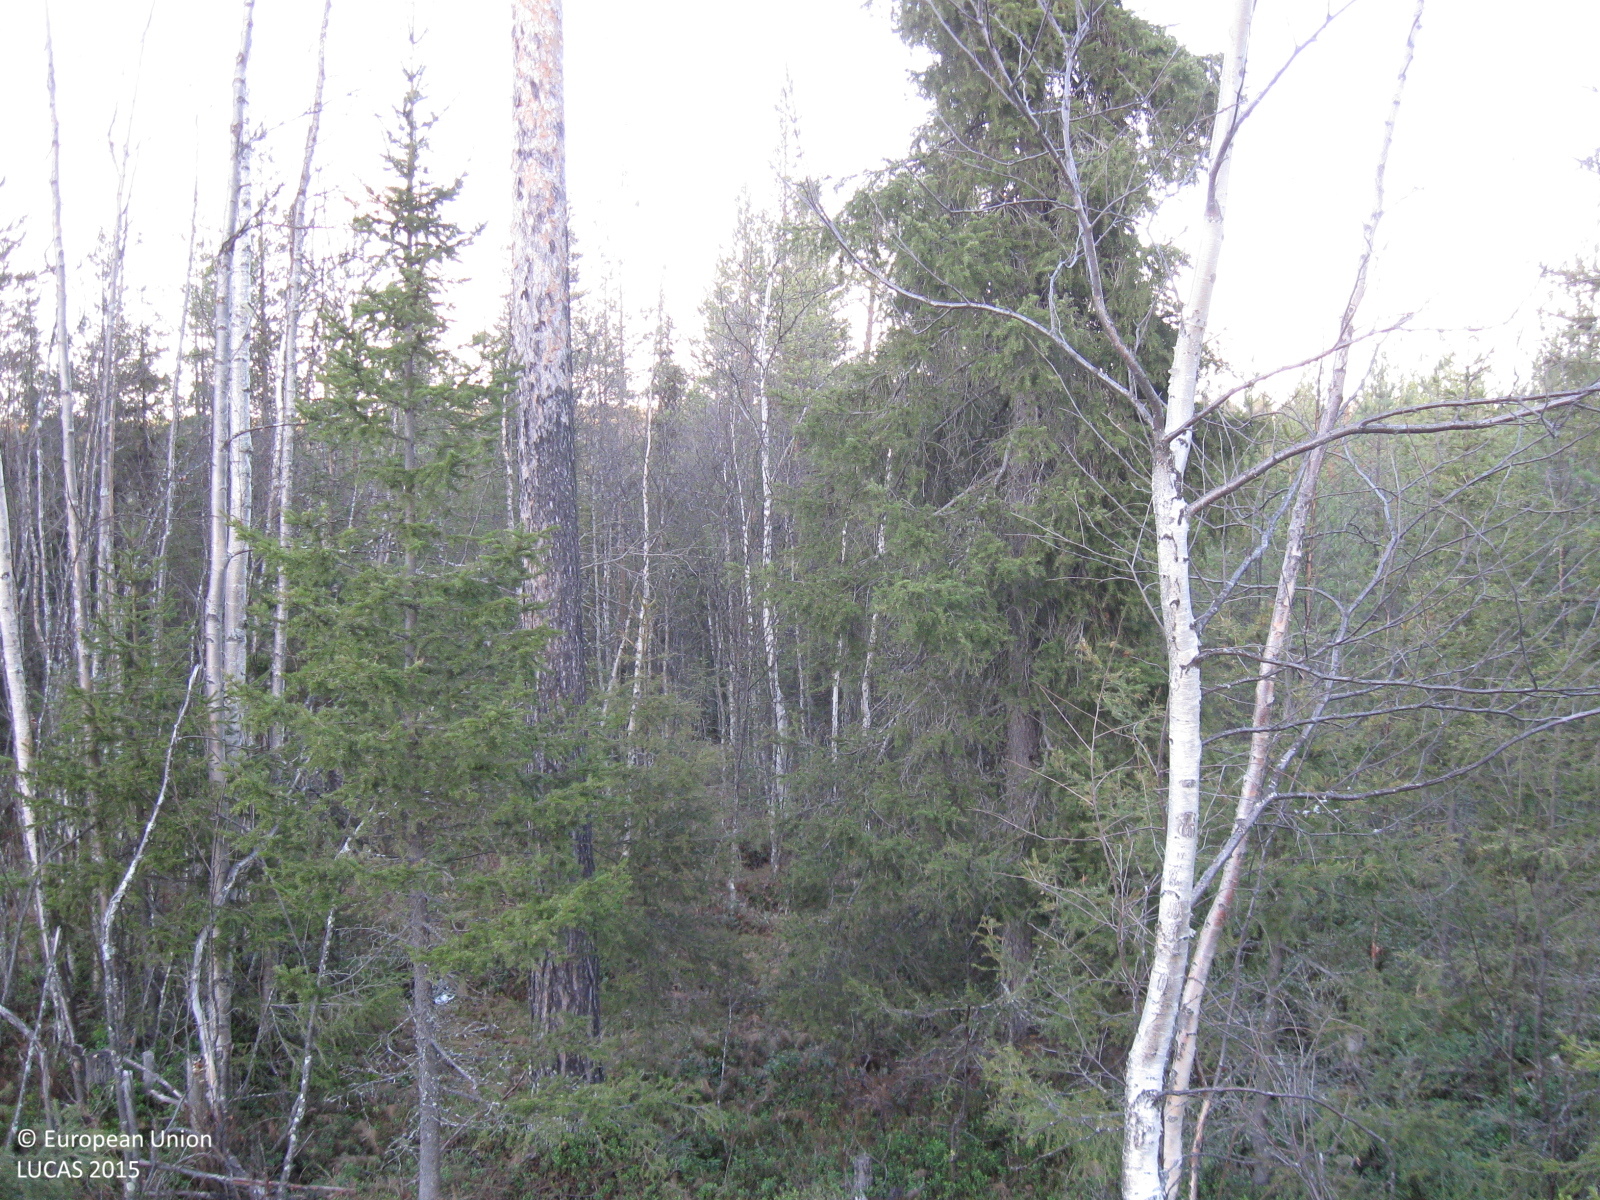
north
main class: Woodland
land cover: Other mixed woodland
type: boreal forest
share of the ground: > 75 %
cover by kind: coniferous forest trees 60 %, broadleaved forest trees 20 %, shrubs 10 %, herbaceous plants 10 %
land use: Forestry
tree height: > 5 m
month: November
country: SE
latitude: 66.1985
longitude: 20.5968
